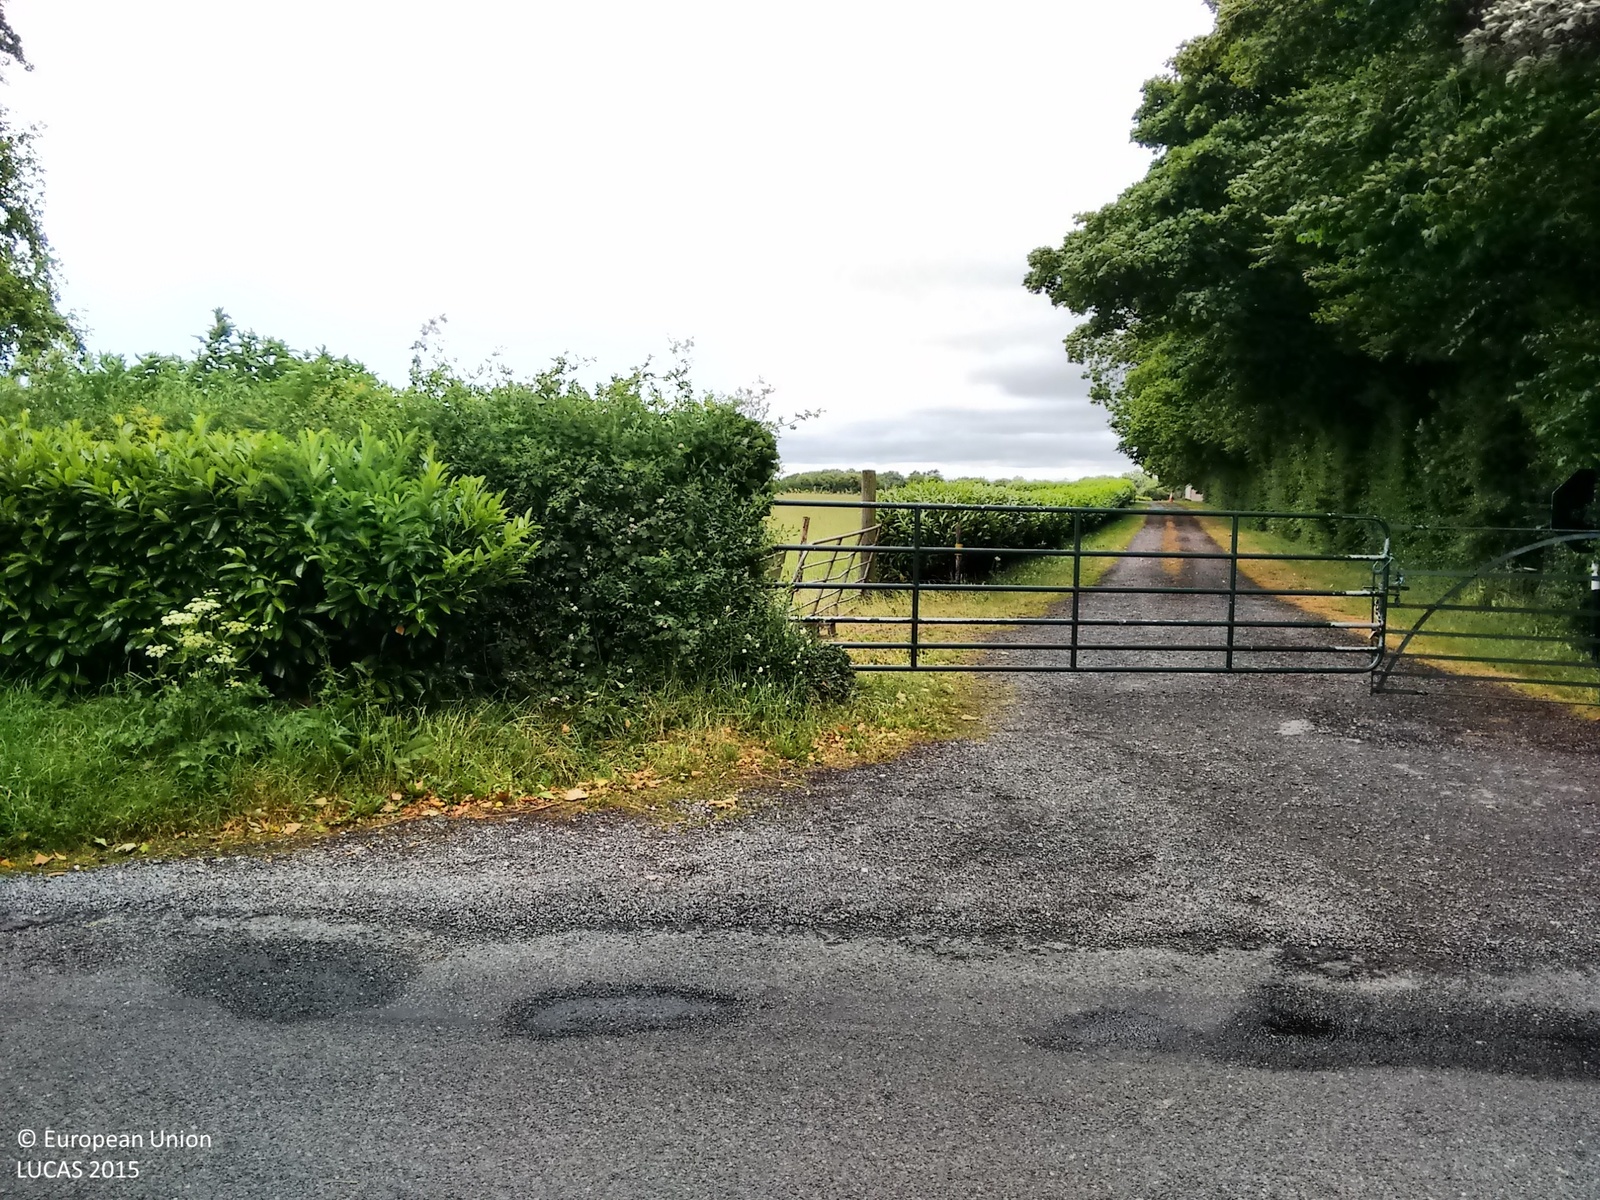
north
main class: Grassland
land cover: Grassland without tree/shrub cover
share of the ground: > 75 %
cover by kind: herbaceous plants 100 %
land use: Agriculture (excluding fallow land and kitchen gardens)
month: July
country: IE
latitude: 53.3339
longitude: -6.6963
